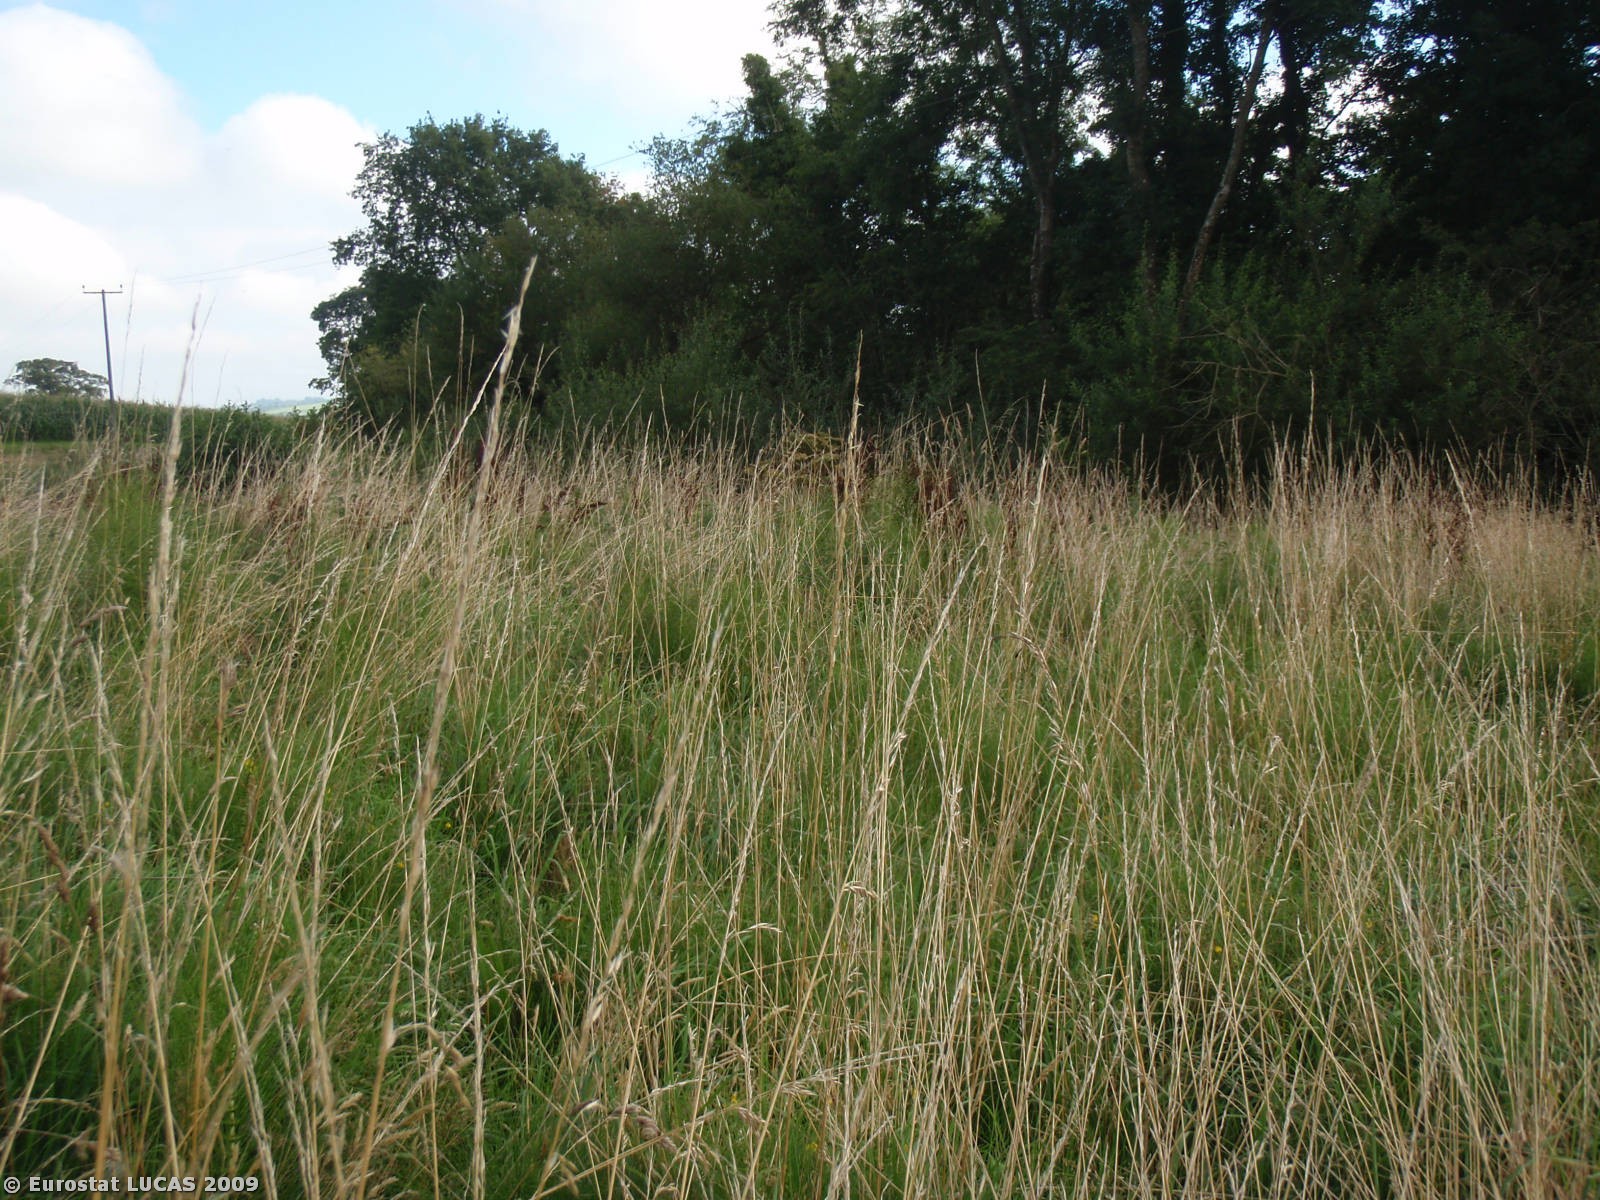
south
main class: Grassland
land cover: Grassland without tree/shrub cover
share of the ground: > 75 %
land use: Unused
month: August
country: GB
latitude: 50.8108
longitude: -2.5992
